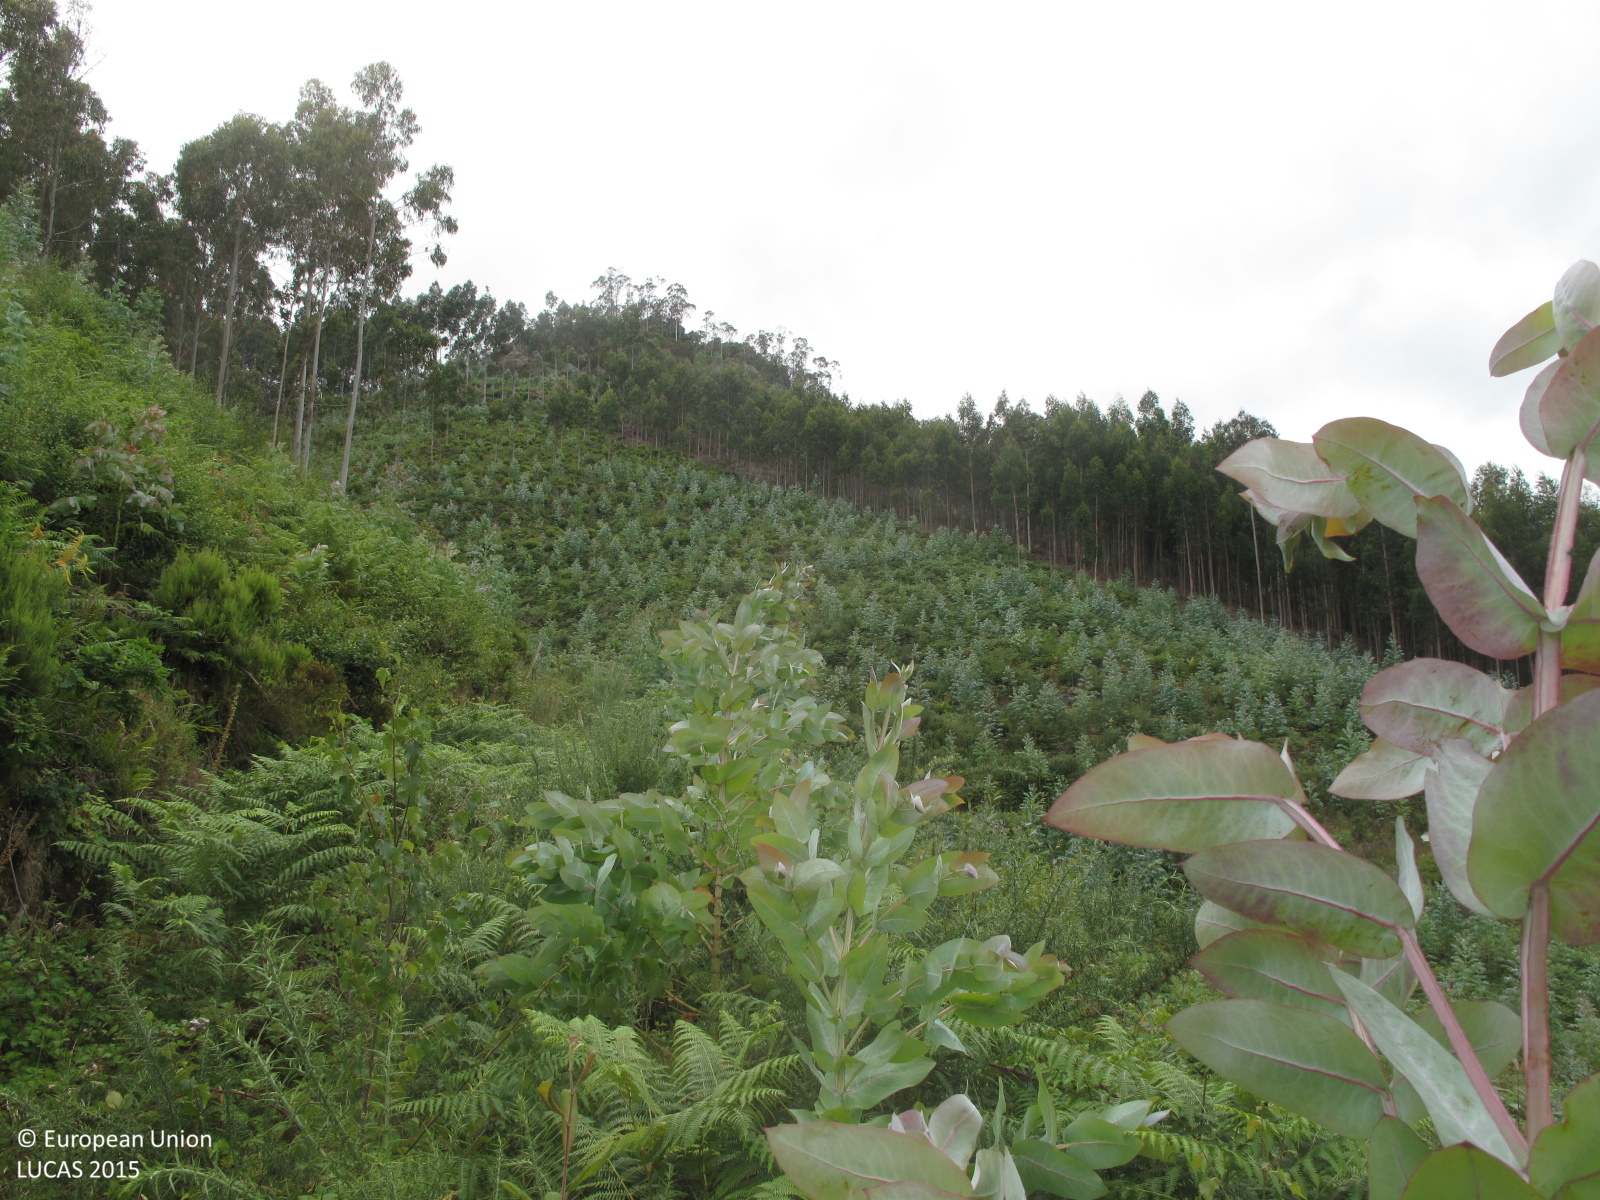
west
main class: Woodland
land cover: Broadleaved woodland
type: exotic forest
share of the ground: 10 - 25 %
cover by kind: herbaceous plants 70 %, broadleaved forest trees 20 %, shrubs 10 %
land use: Forestry
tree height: < 5 m
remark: Clear cut
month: July
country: ES
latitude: 43.4824
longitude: -7.9860
